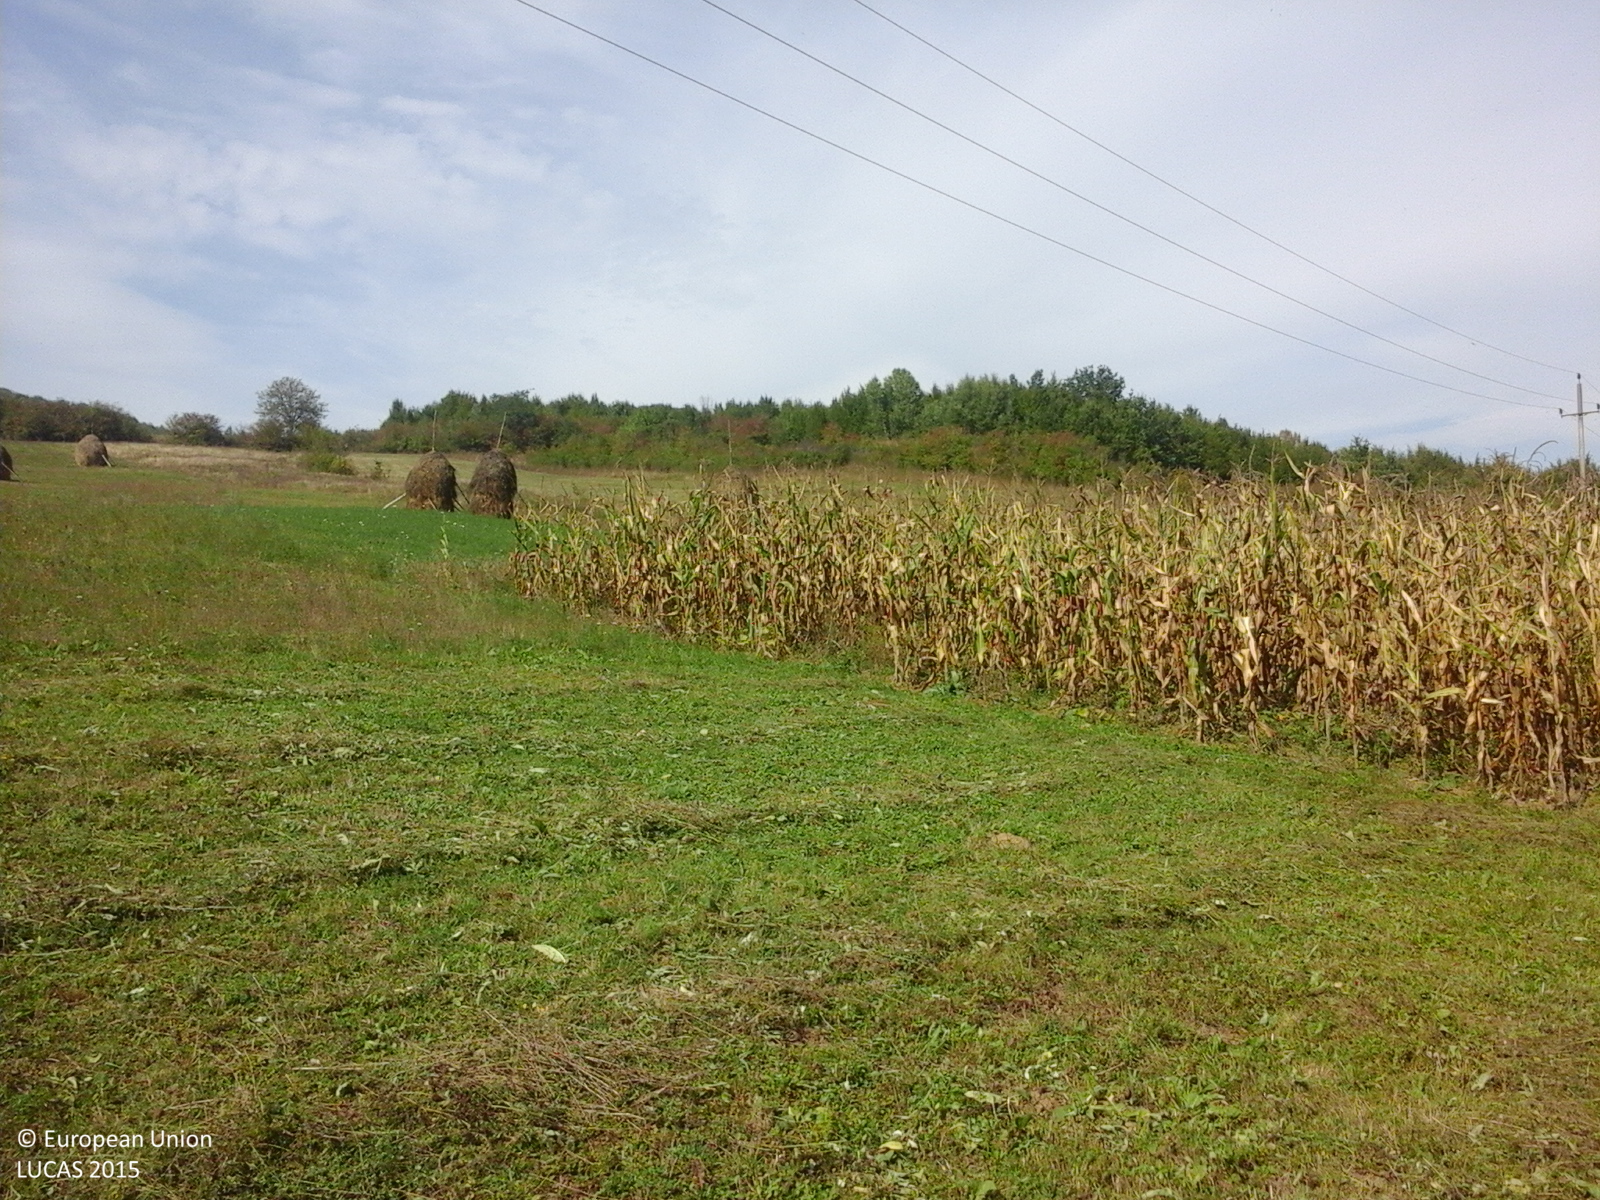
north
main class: Grassland
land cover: Grassland without tree/shrub cover
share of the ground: > 75 %
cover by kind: herbaceous plants 100 %
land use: Agriculture (excluding fallow land and kitchen gardens)
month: September
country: RO
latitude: 47.3177
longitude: 23.7704
